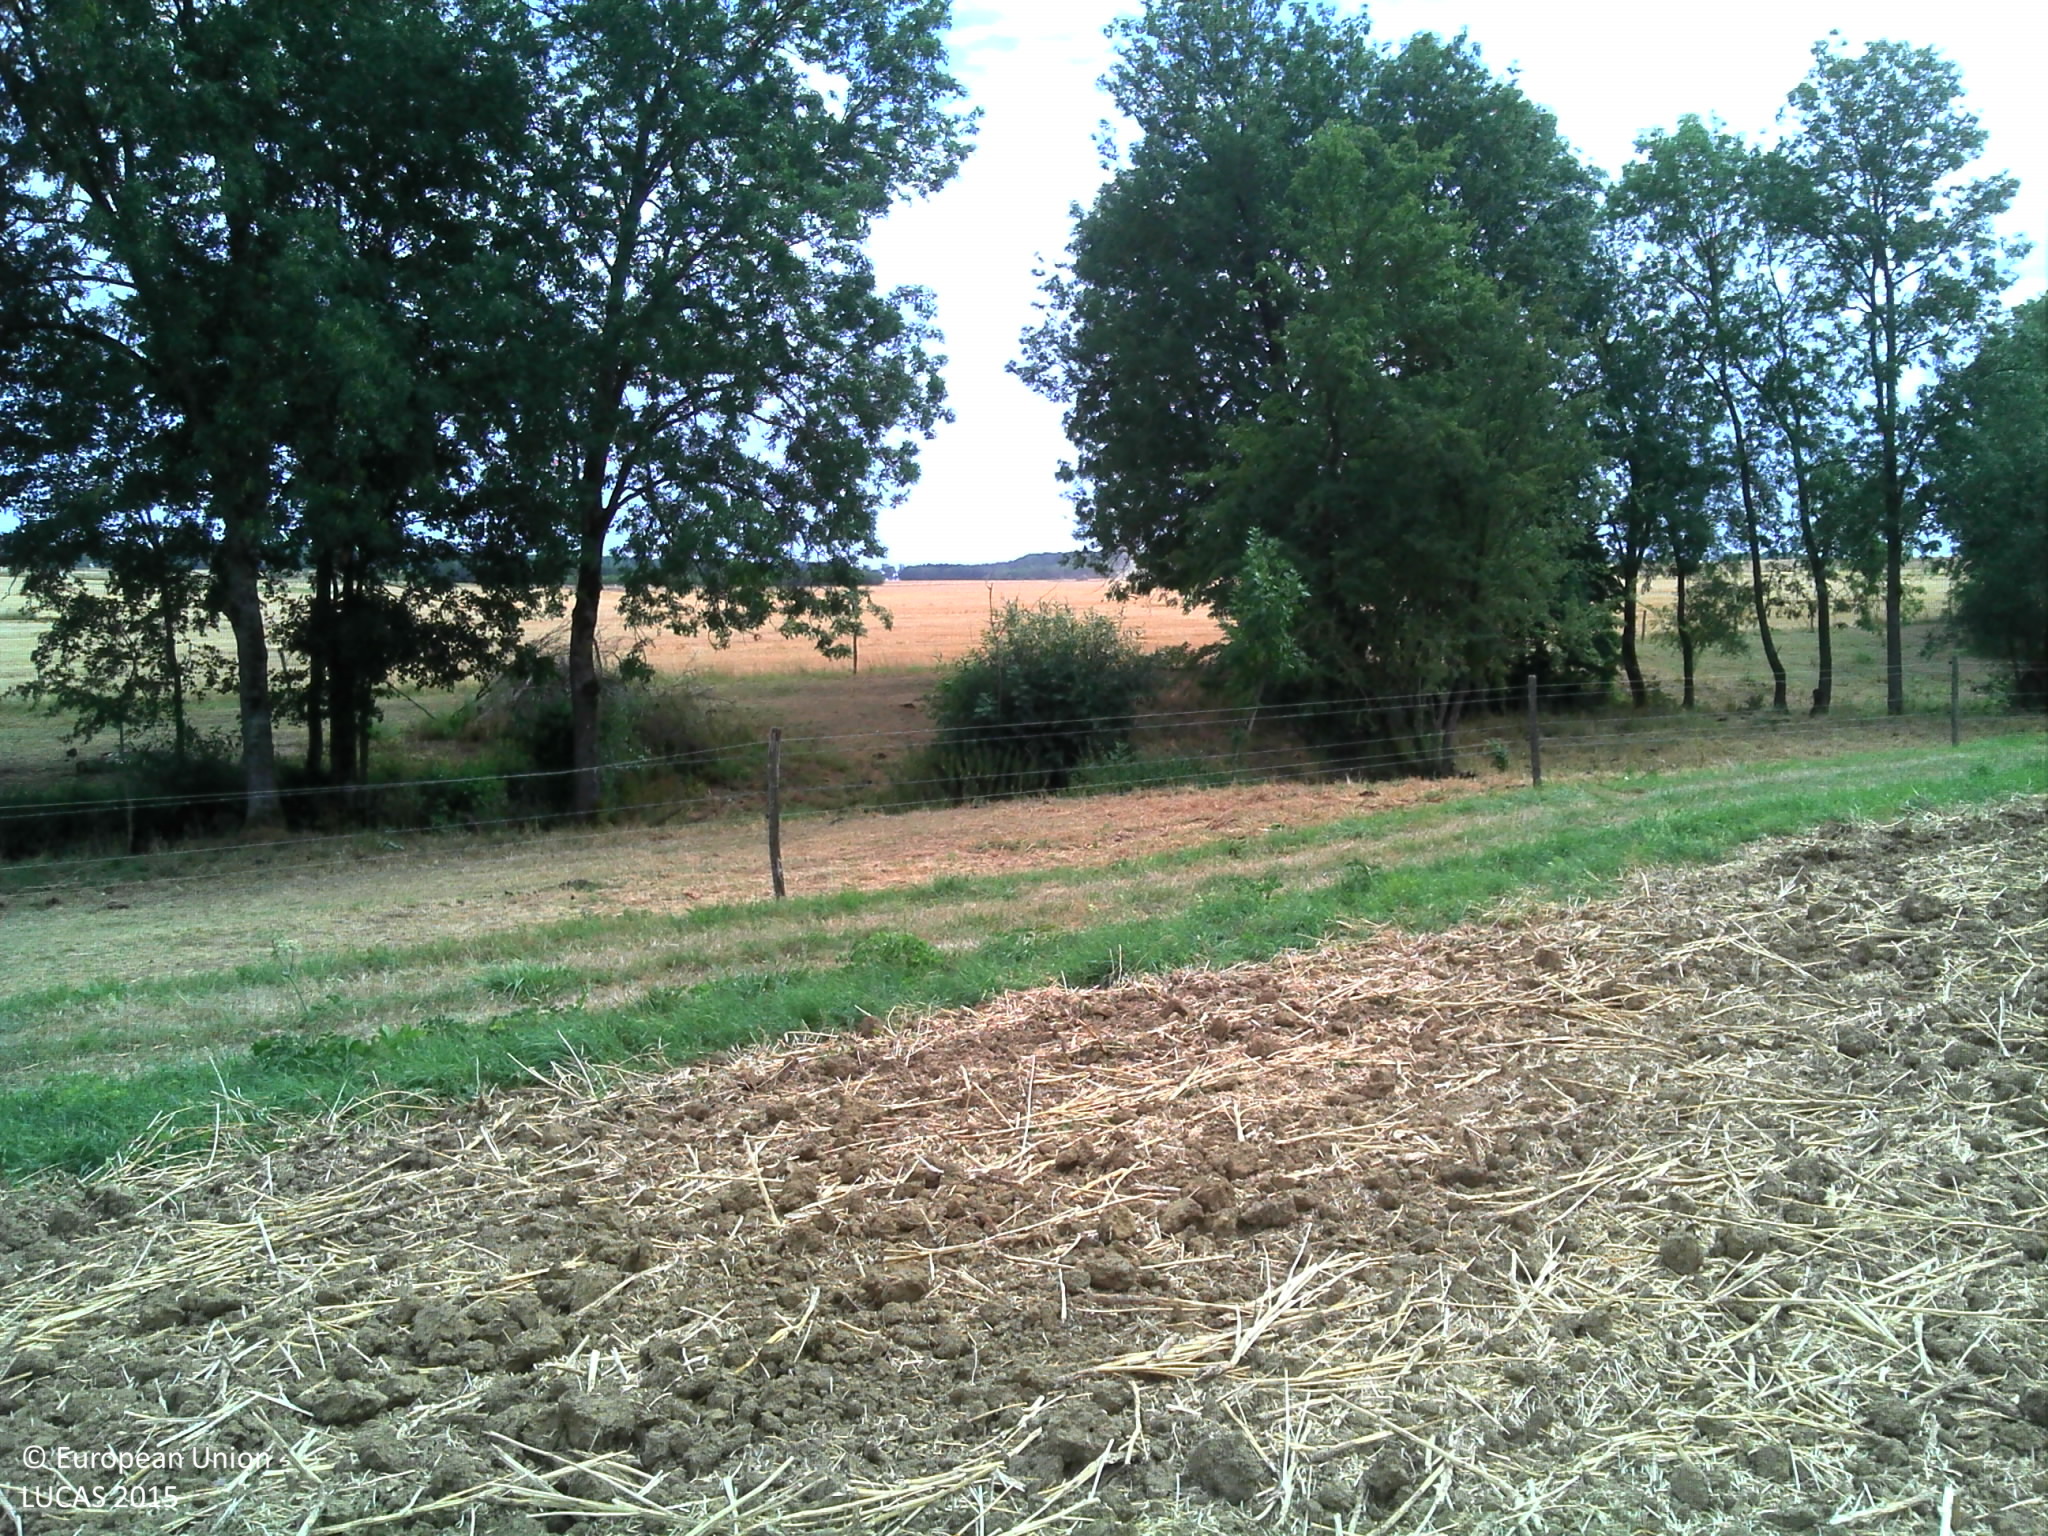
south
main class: Cropland
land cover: Rape and turnip rape
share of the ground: > 75 %
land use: Agriculture (excluding fallow land and kitchen gardens)
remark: Harvested field
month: July
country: FR
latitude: 48.3896
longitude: 6.1245
